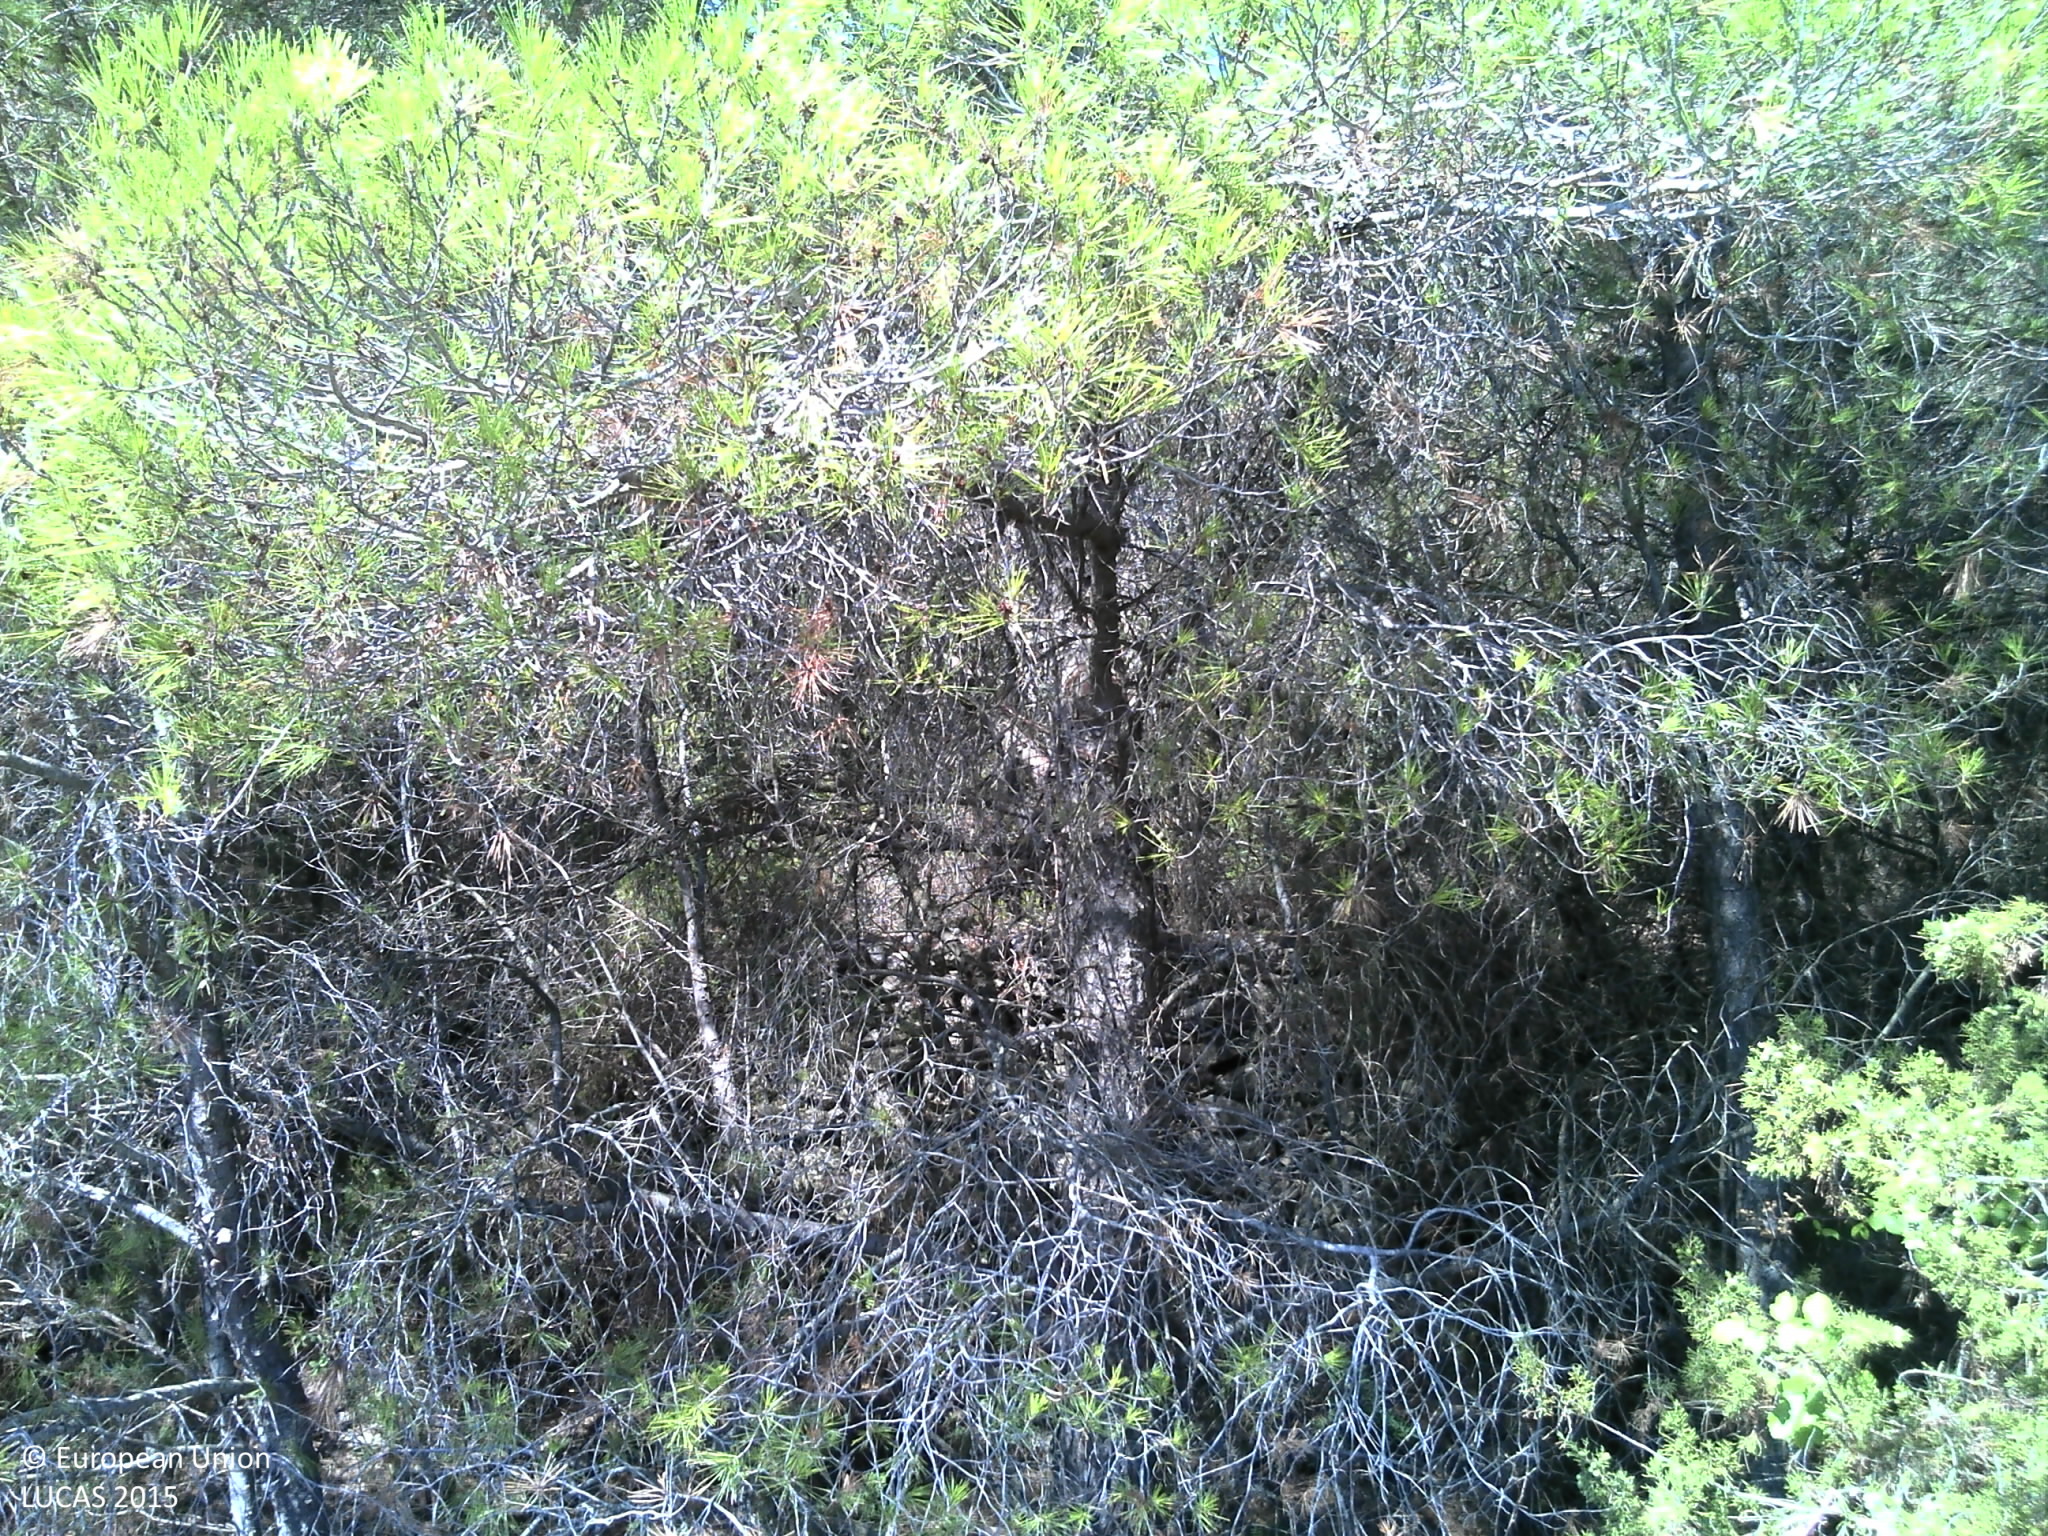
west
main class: Woodland
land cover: Pine dominated coniferous woodland
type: coniferous forest of the mediterranean region
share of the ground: > 75 %
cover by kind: coniferous forest trees 75 %, shrubs 10 %, herbaceous plants 10 %, unconsolidated bare surface 5 %
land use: Semi-natural and natural areas not in use
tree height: > 5 m
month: August
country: HR
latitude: 43.0276
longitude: 16.1614
